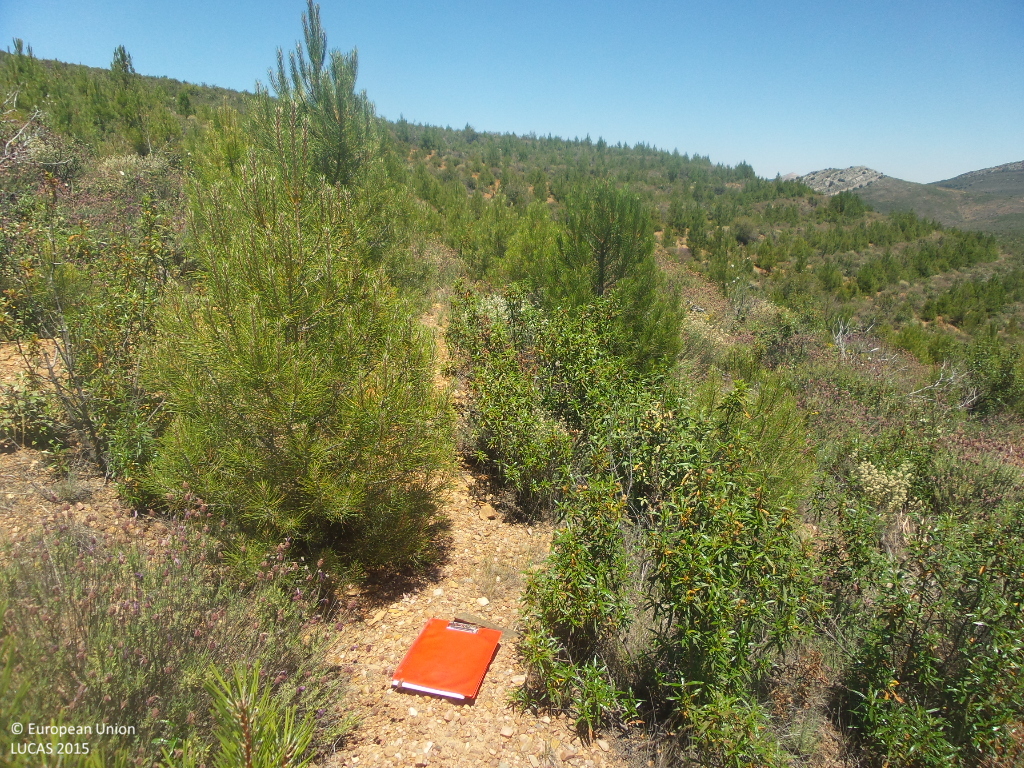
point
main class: Woodland
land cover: Pine dominated coniferous woodland
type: coniferous forest of the mediterranean region
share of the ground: 10 - 25 %
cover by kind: shrubs 60 %, coniferous forest trees 20 %, unconsolidated bare surface 20 %
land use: Forestry
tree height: < 5 m
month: June
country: ES
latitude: 41.1440
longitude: -2.9401
